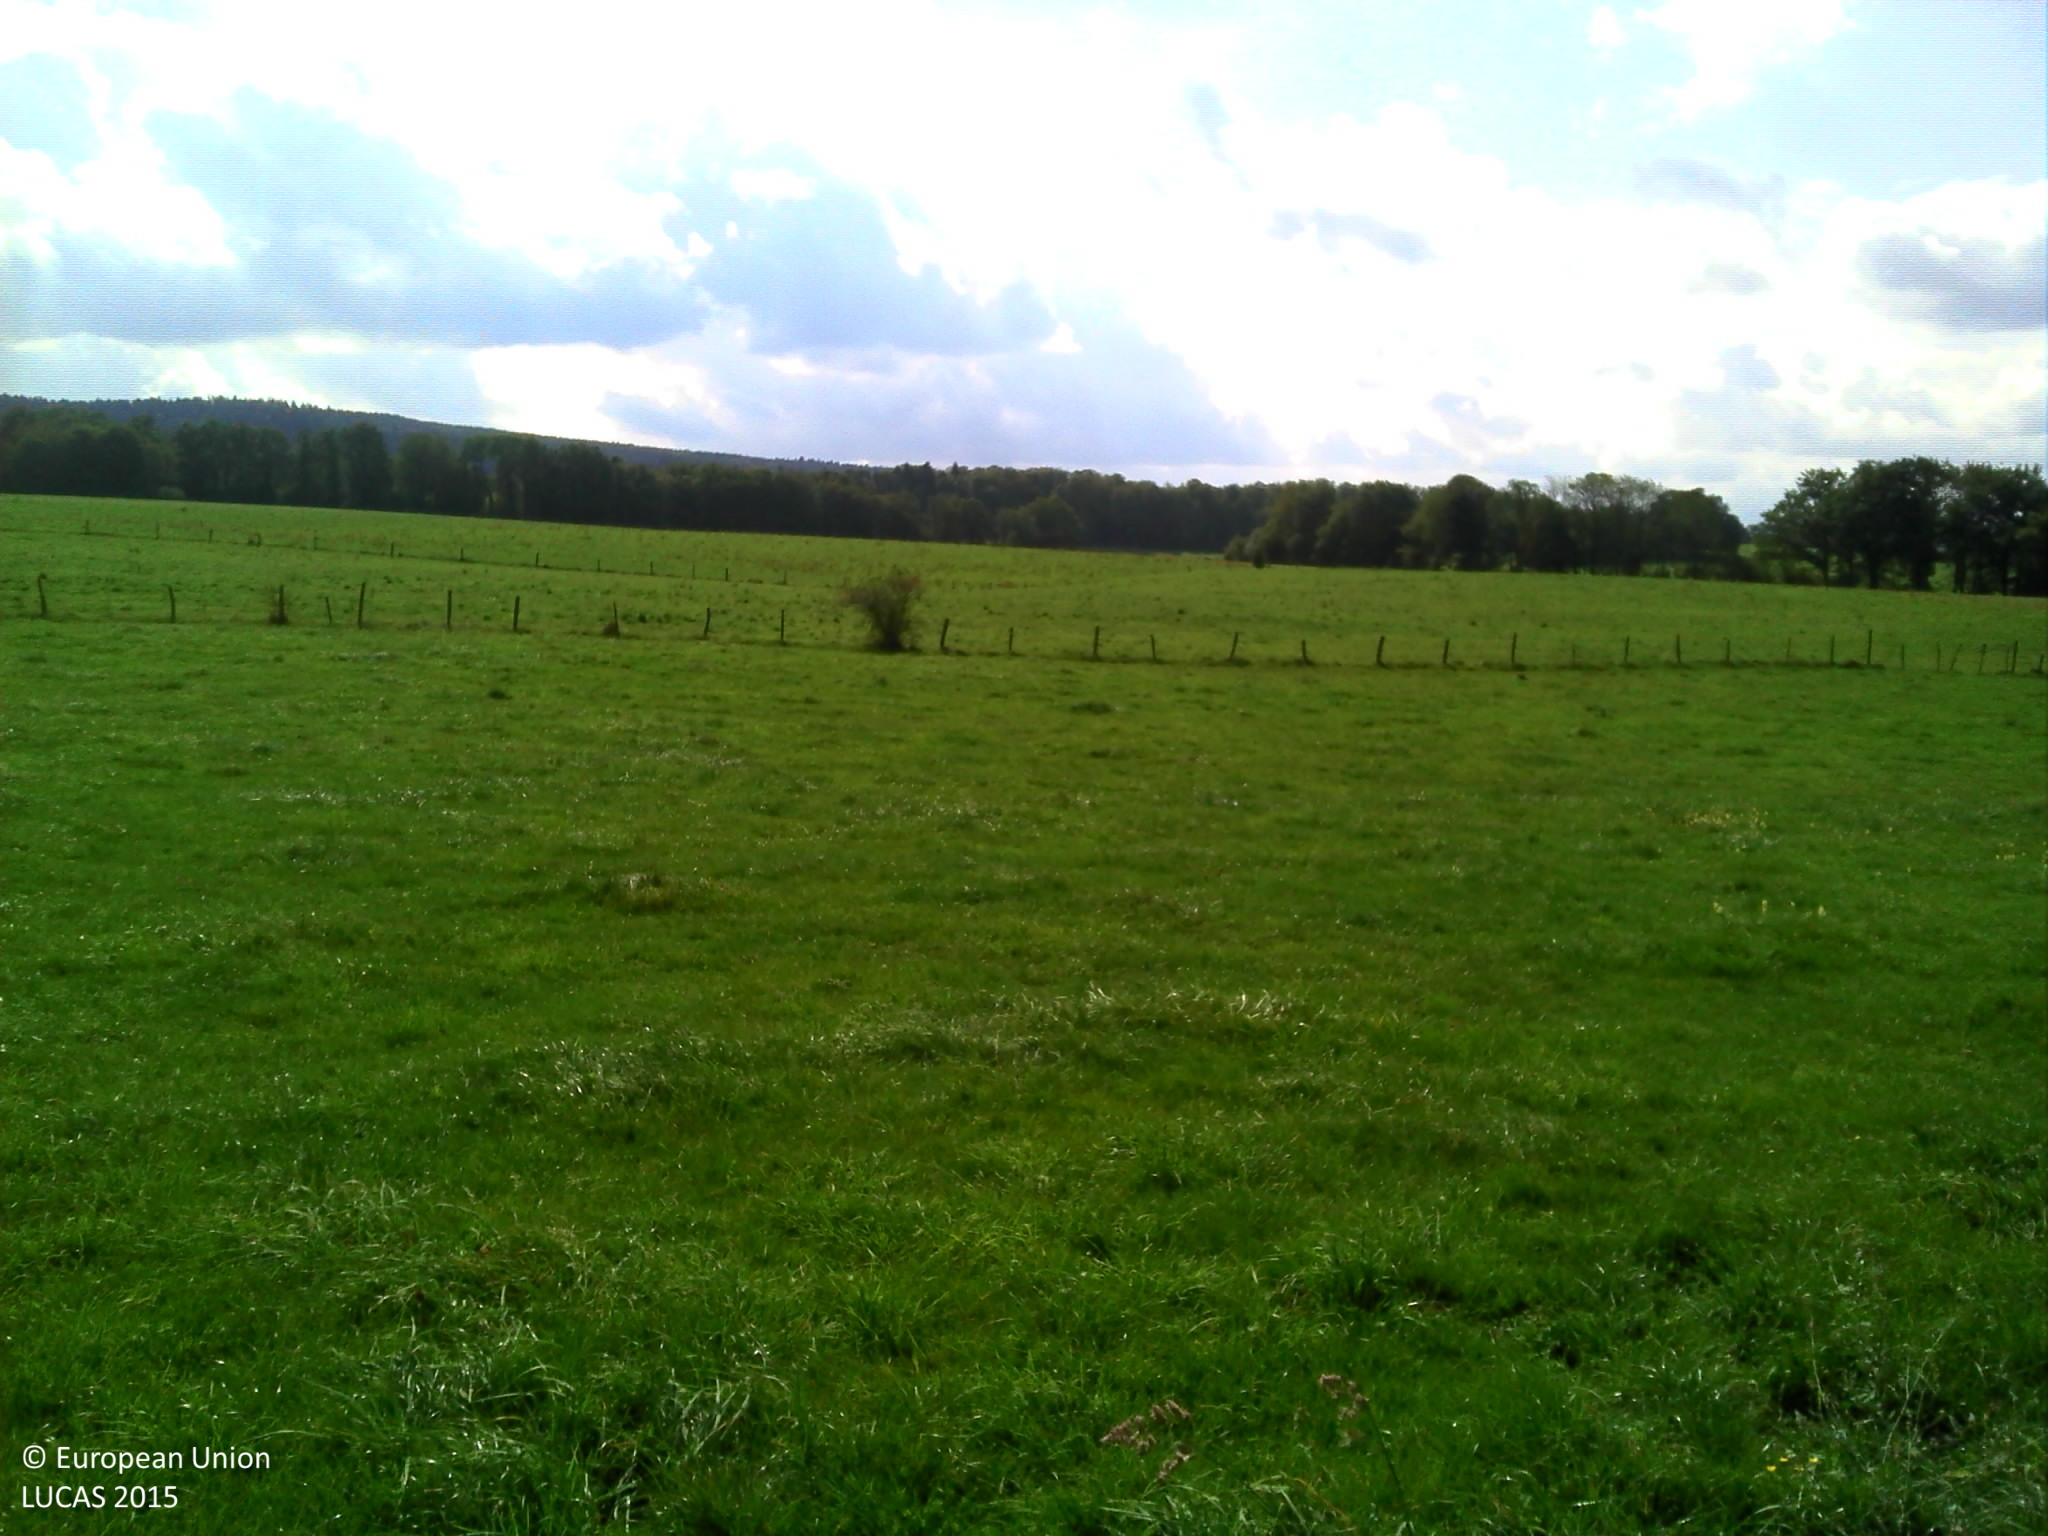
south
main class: Grassland
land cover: Grassland without tree/shrub cover
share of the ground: > 75 %
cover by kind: herbaceous plants 100 %
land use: Agriculture (excluding fallow land and kitchen gardens)
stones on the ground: < 10 %
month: September
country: FR
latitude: 47.1730
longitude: 6.3737
